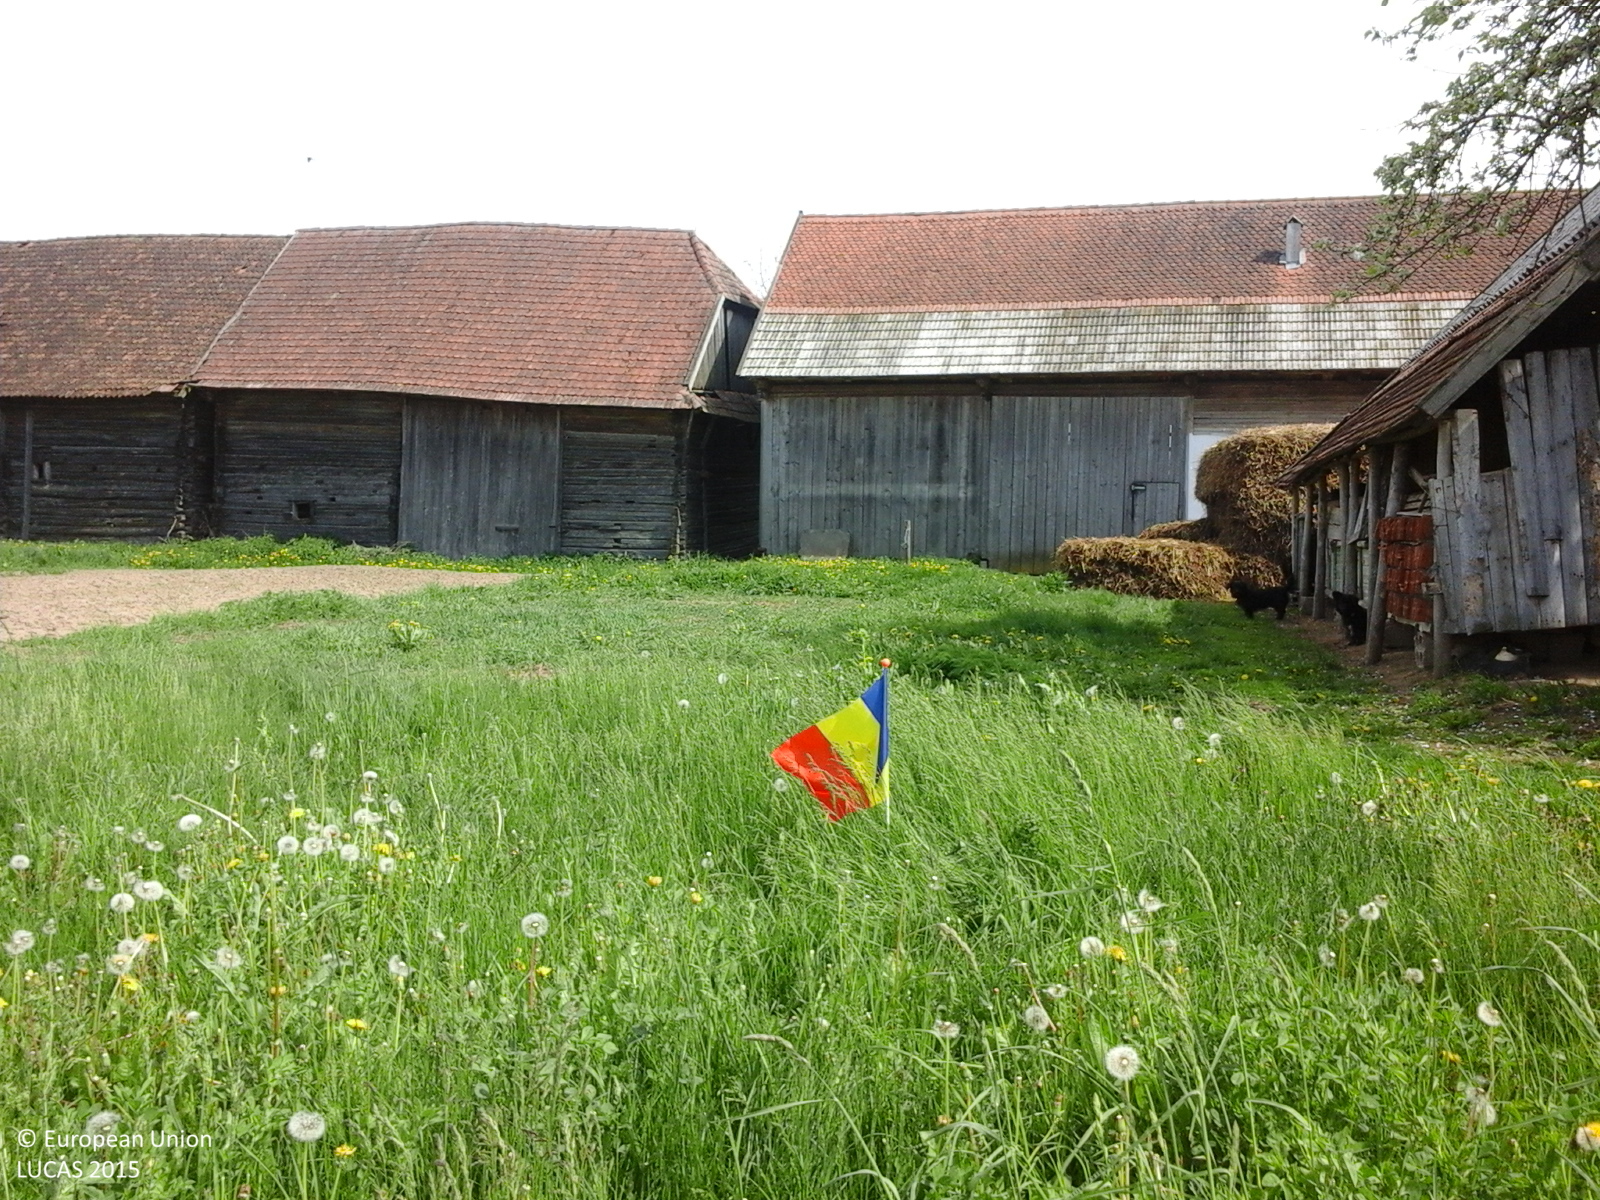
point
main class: Cropland
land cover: Other leguminous and mixtures for fodder
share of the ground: > 75 %
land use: Agriculture (excluding fallow land and kitchen gardens)
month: May
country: RO
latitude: 45.8631
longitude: 26.0506
